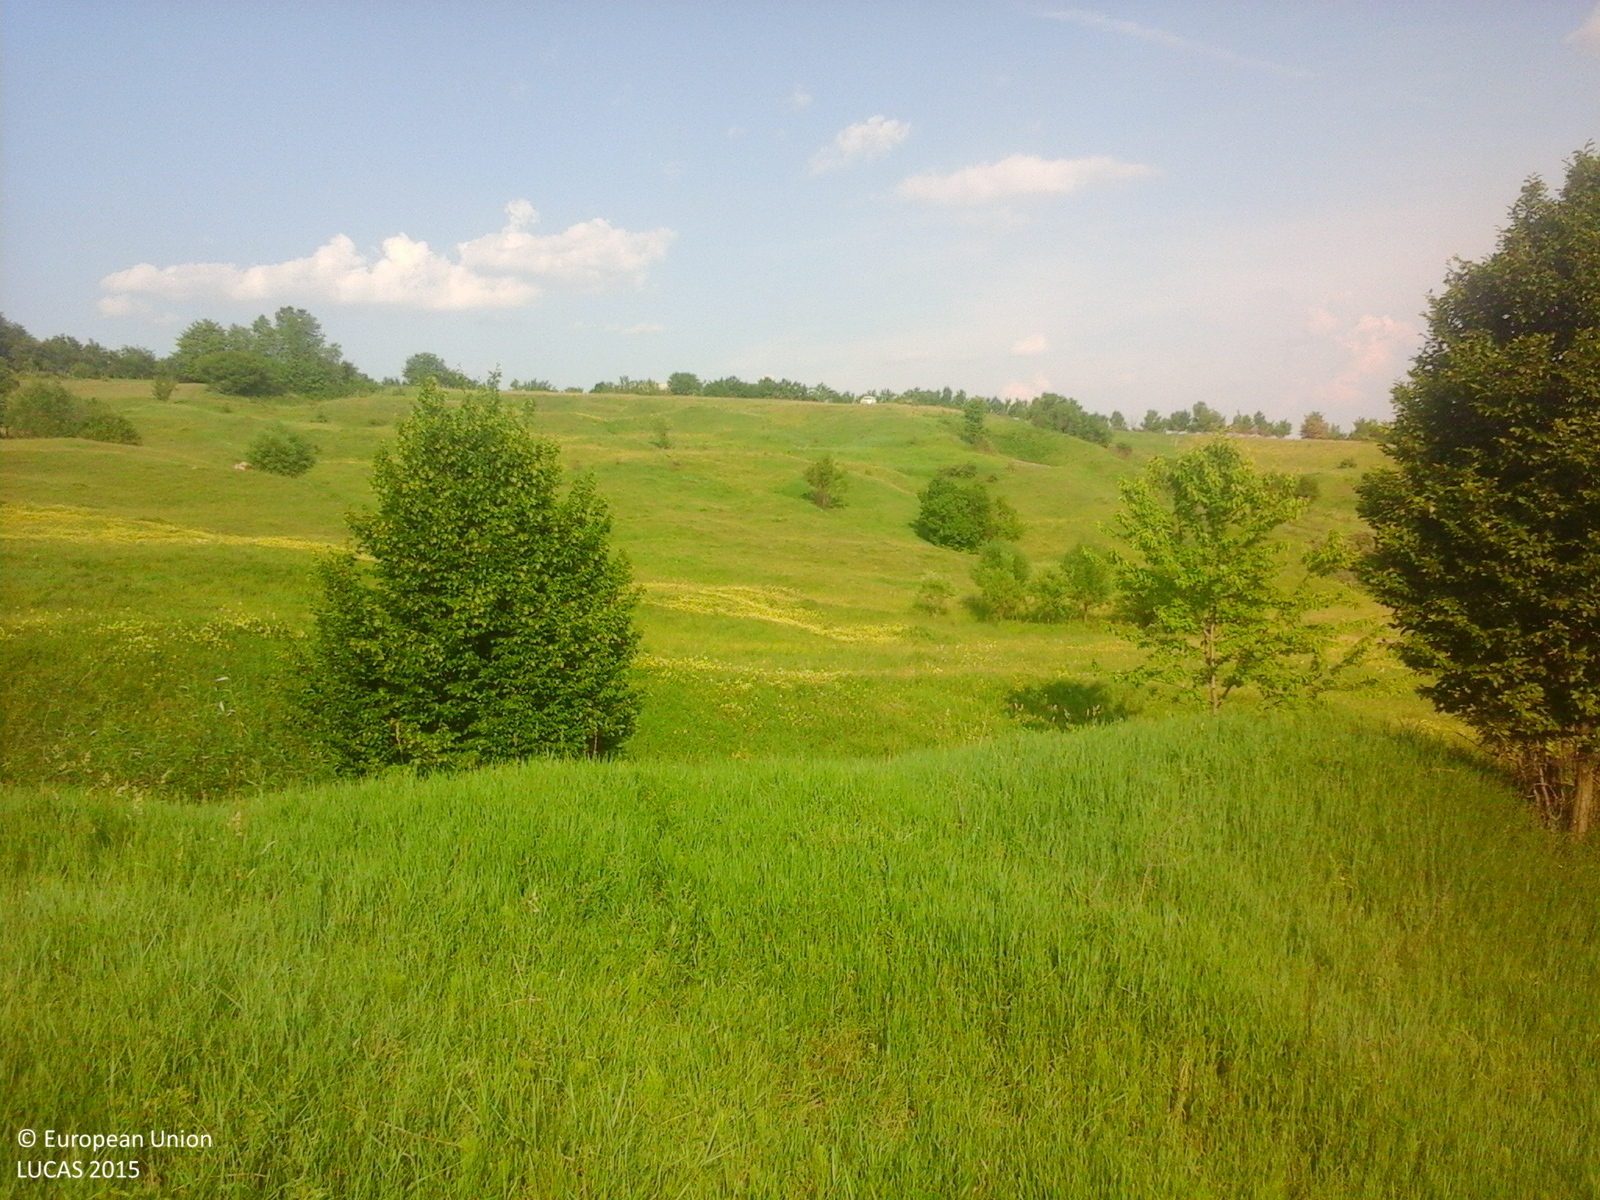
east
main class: Grassland
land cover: Grassland without tree/shrub cover
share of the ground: > 75 %
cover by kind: herbaceous plants 100 %
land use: Agriculture (excluding fallow land and kitchen gardens)
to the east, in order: Grassland without tree/shrub cover; Broadleaved woodland; Ditches and canals; Broadleaved woodland; Grassland without tree/shrub cover; Single bushes/trees; Grassland without tree/shrub cover
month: June
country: RO
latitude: 46.6996
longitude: 26.5771
